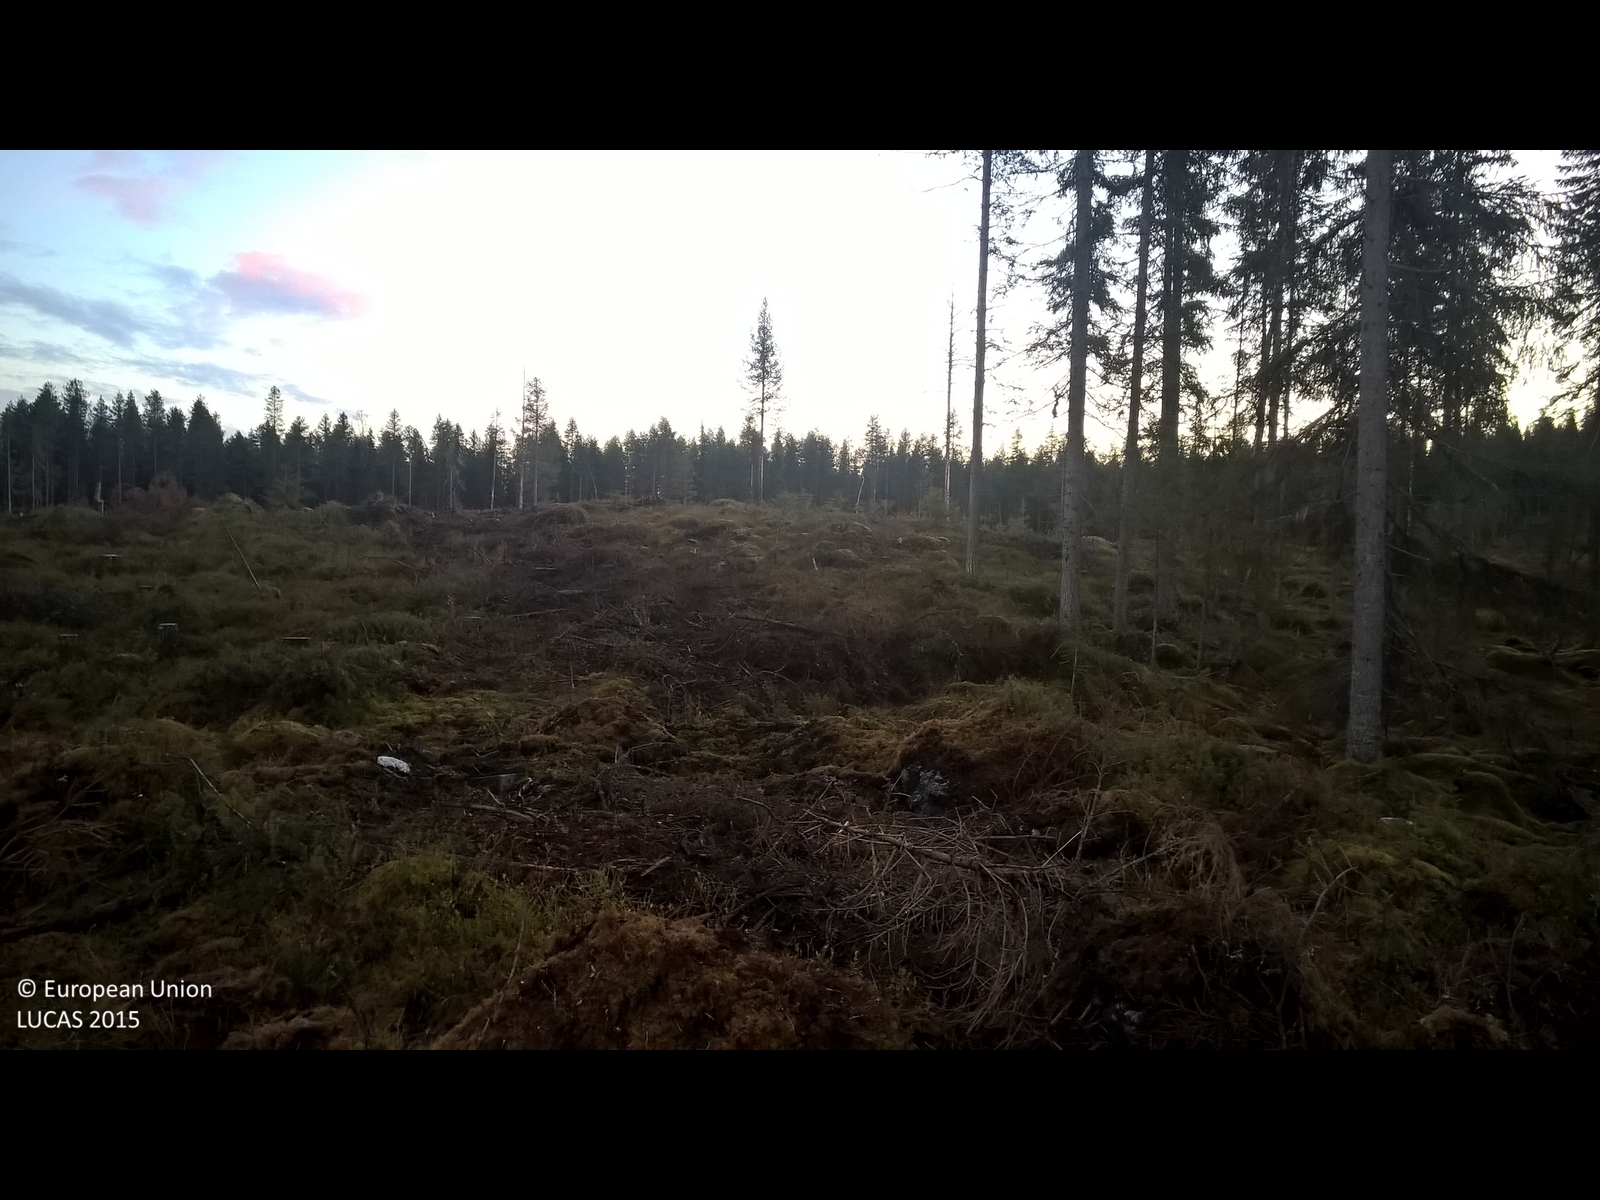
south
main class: Shrubland
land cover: Shrubland with sparse tree cover
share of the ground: > 75 %
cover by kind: shrubs 85 %, herbaceous plants 10 %, coniferous forest trees 5 %
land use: Forestry
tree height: < 5 m
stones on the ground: < 10 %
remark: Clear cut
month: October
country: SE
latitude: 65.1106
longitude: 18.2467
